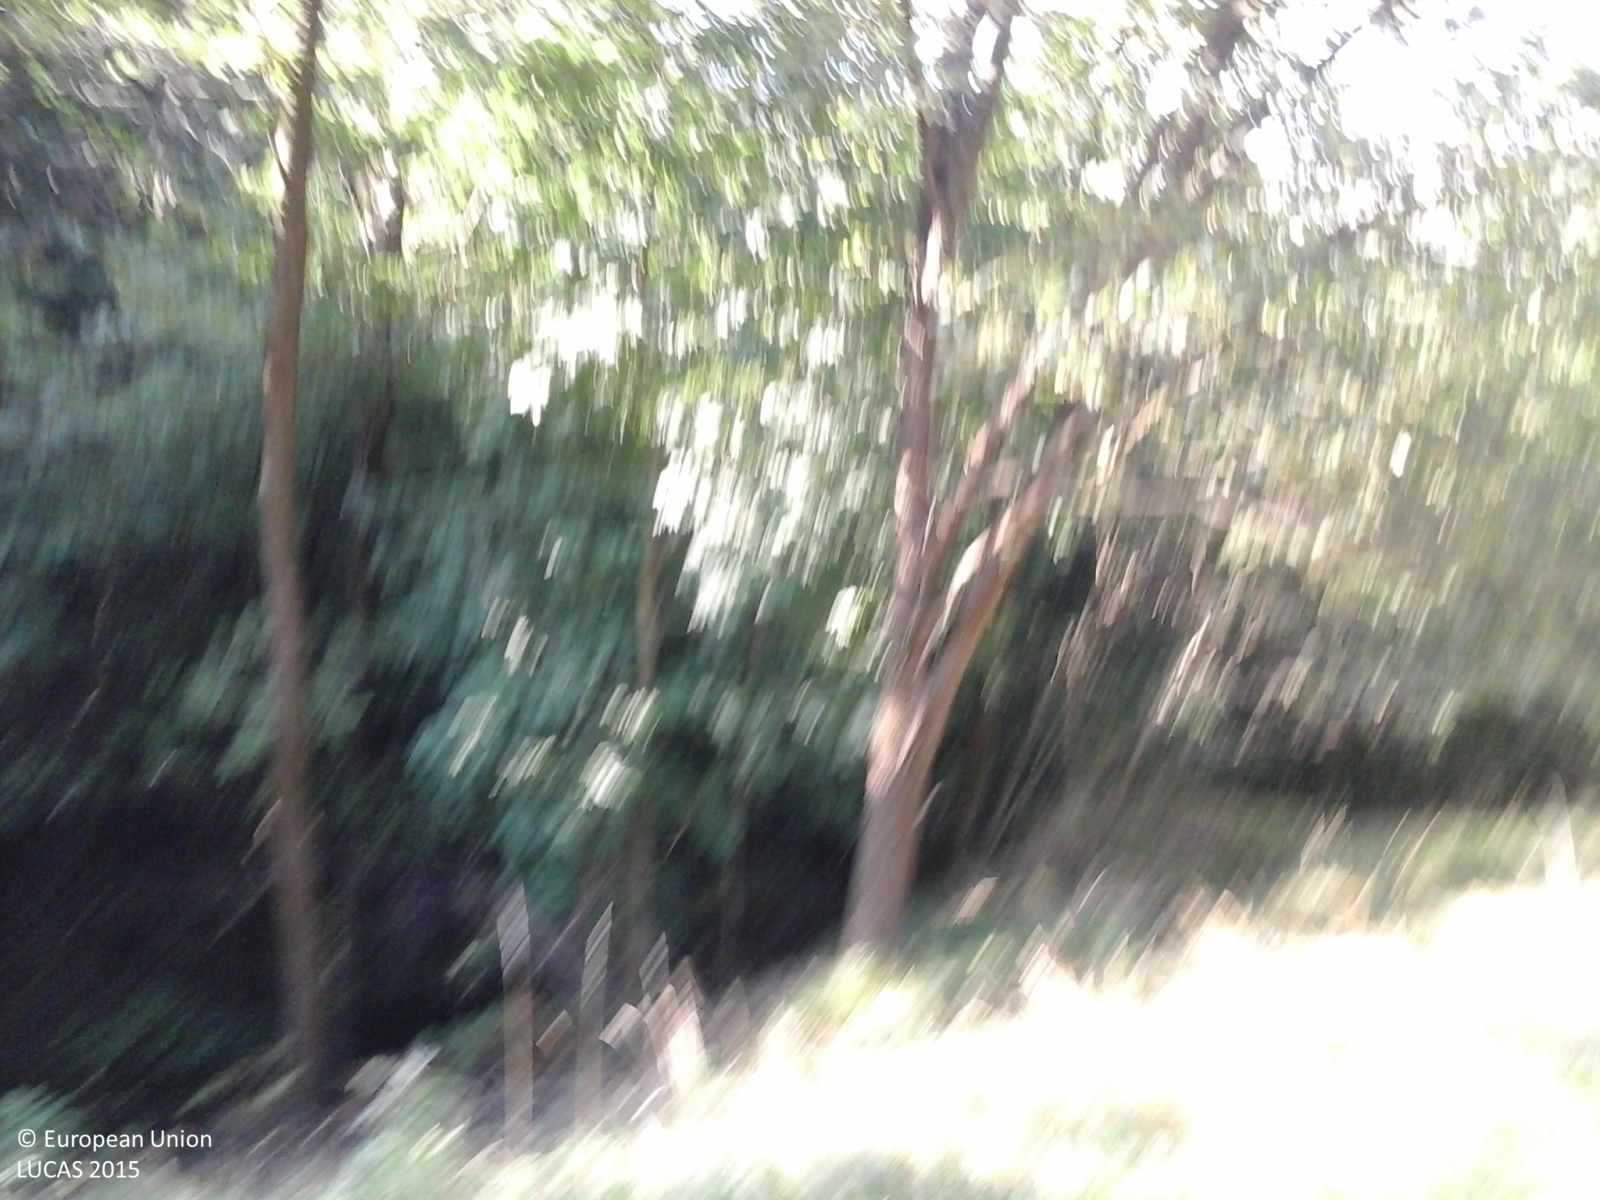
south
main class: Woodland
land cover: Broadleaved woodland
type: thermophilous deciduous forest
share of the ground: > 75 %
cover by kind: broadleaved forest trees 100 %
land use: Semi-natural and natural areas not in use
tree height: > 5 m
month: September
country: IT
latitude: 44.5583
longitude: 8.6558
